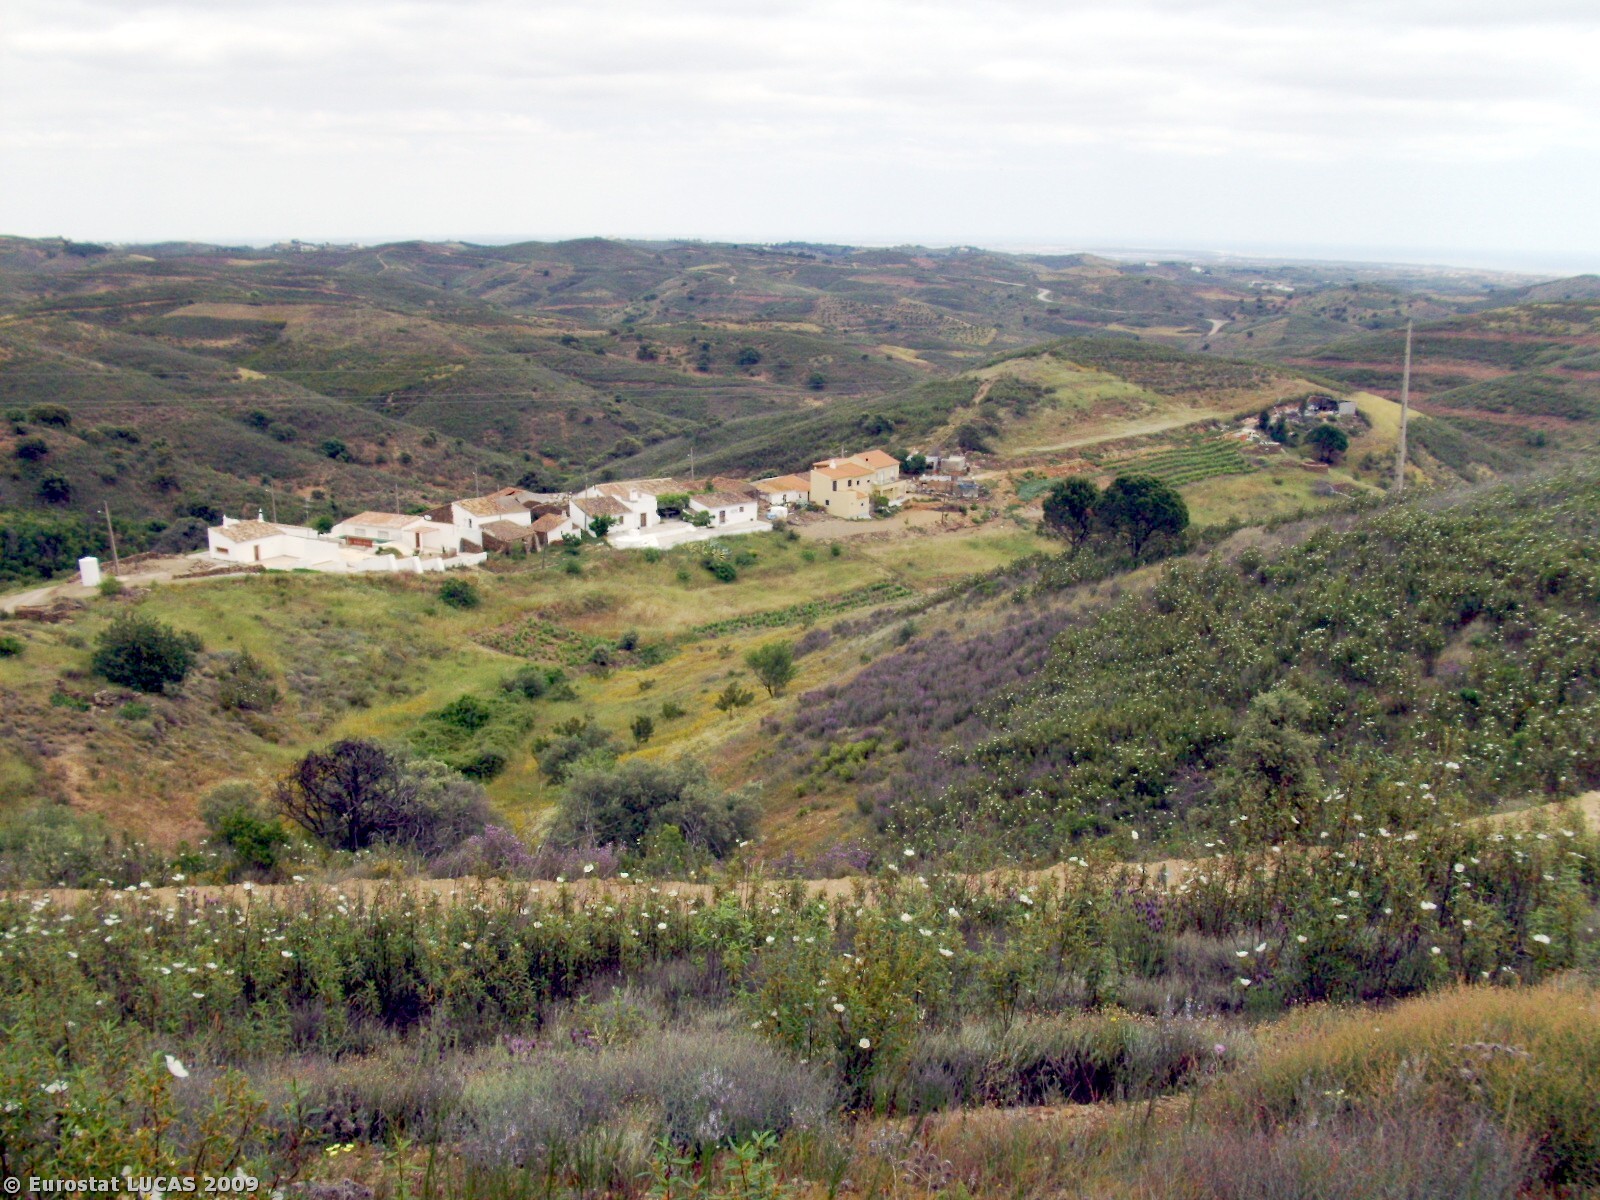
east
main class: Shrubland
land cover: Shrubland without tree cover
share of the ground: > 75 %
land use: Unused
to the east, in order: Shrubland without tree cover; Paved roads, cycling and walking lanes; Shrubland without tree cover; Grassland without tree/shrub cover; Ditches and canals; Vineyards; Grassland without tree/shrub cover; Artificial constructions in urban areas; Tracks
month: April
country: PT
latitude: 37.2345
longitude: -7.6242
